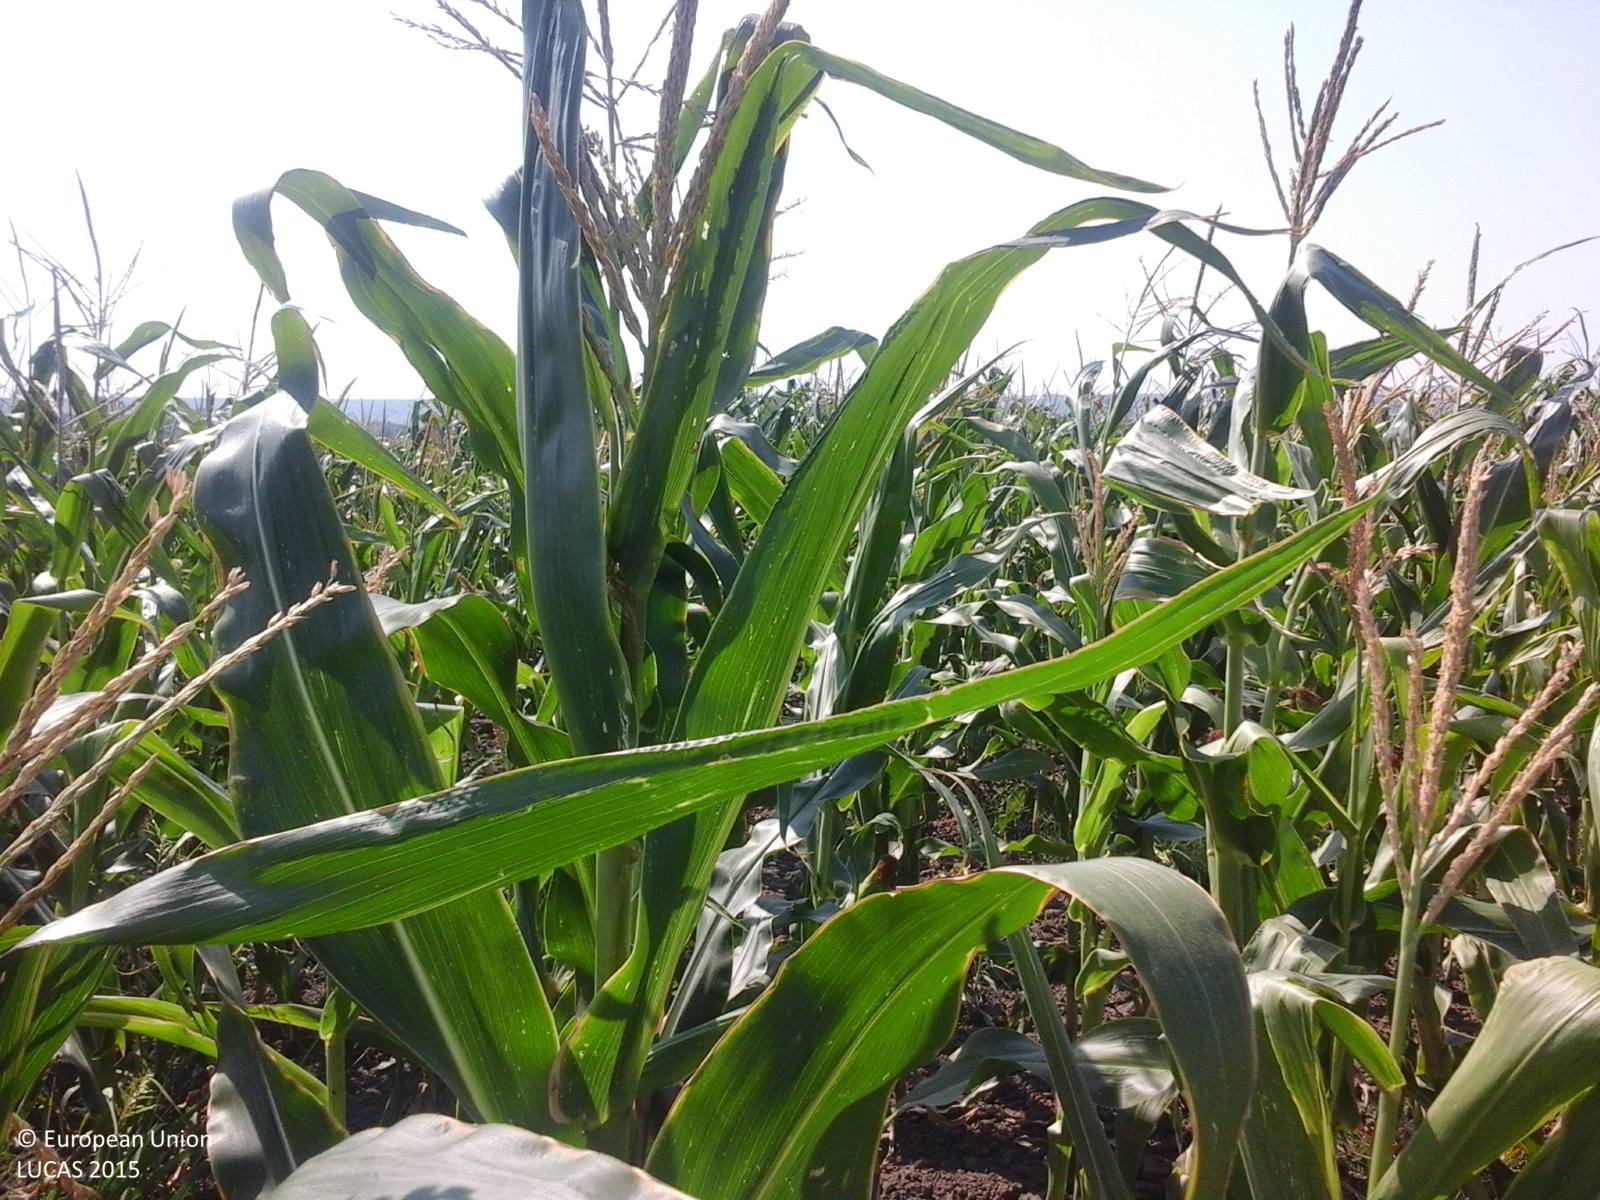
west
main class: Cropland
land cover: Maize
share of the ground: > 75 %
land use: Agriculture (excluding fallow land and kitchen gardens)
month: July
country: RO
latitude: 46.0031
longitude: 27.4741
